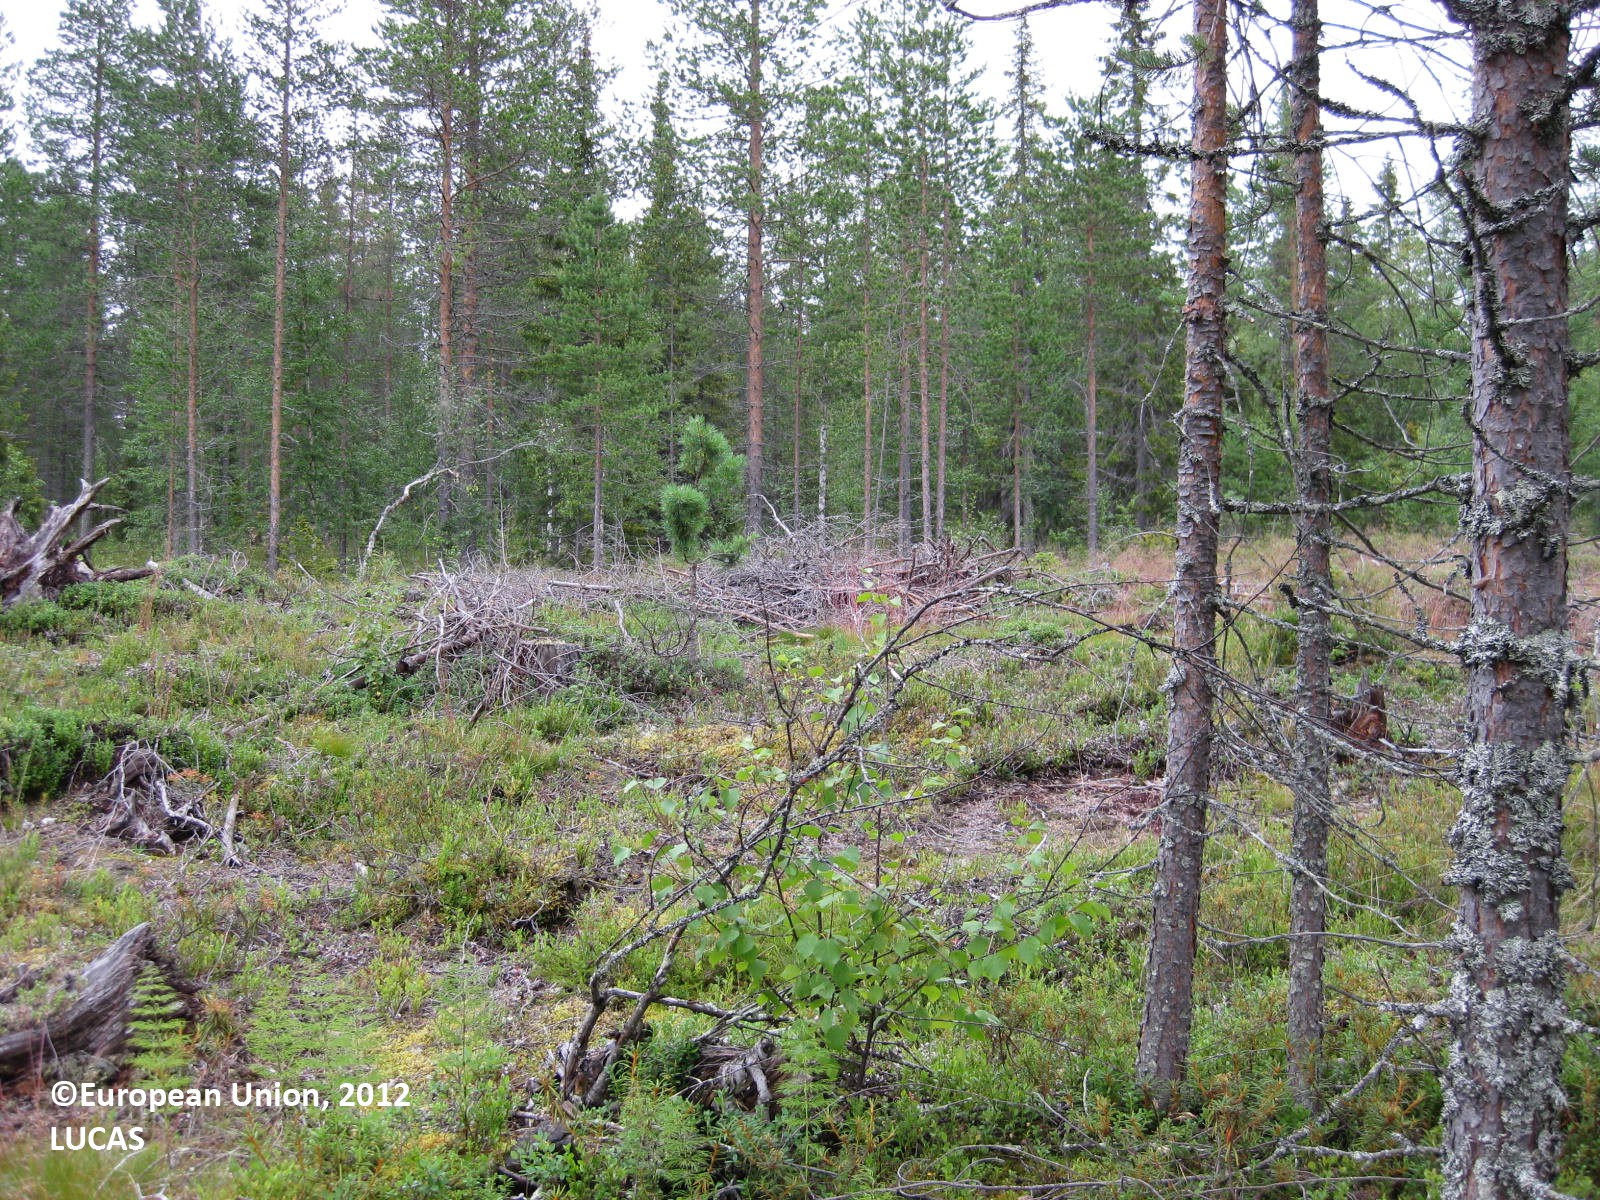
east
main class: Woodland
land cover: Pine dominated coniferous woodland
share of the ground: 50 - 75 %
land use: Forestry
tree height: > 5 m
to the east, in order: Pine dominated coniferous woodland; Shrubland with sparse tree cover; Ditches and canals; Pine dominated mixed woodland; Pine dominated coniferous woodland
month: August
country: FI
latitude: 65.8939
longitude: 28.1586
